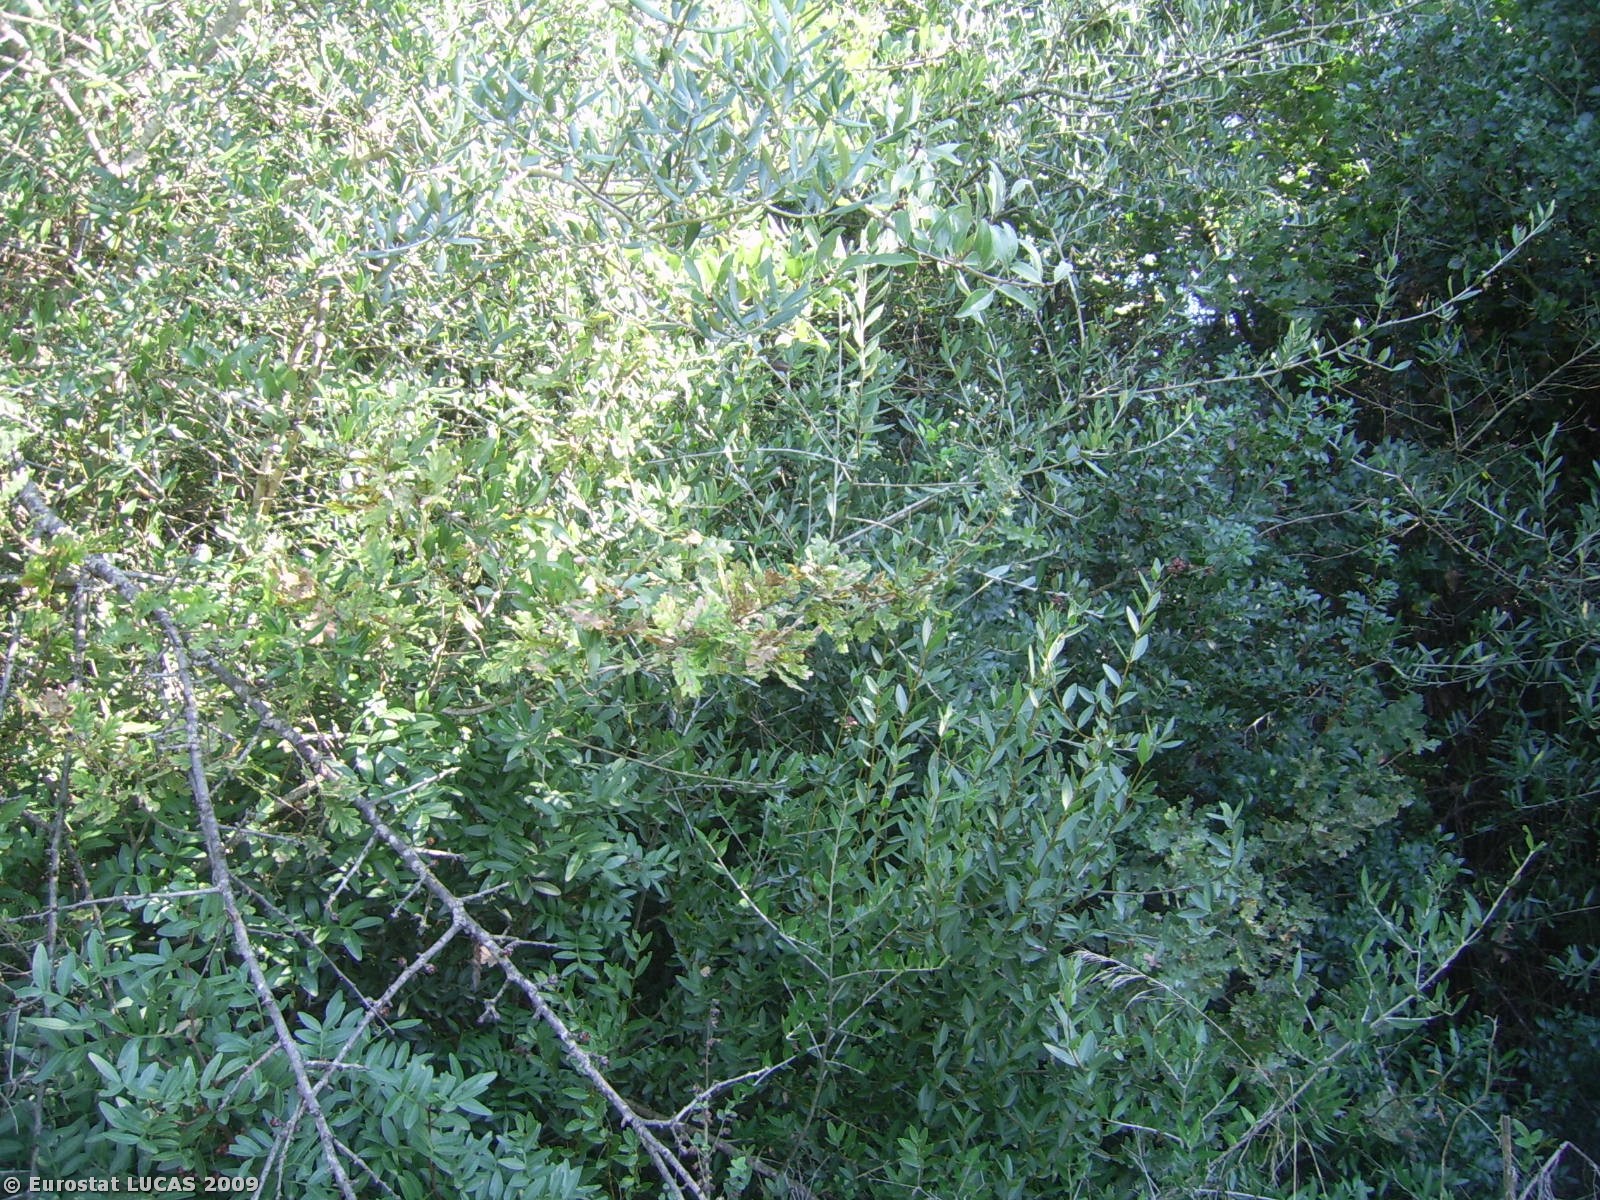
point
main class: Shrubland
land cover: Shrubland with sparse tree cover
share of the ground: > 75 %
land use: Unused
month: October
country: GR
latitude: 37.8279
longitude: 21.4014
